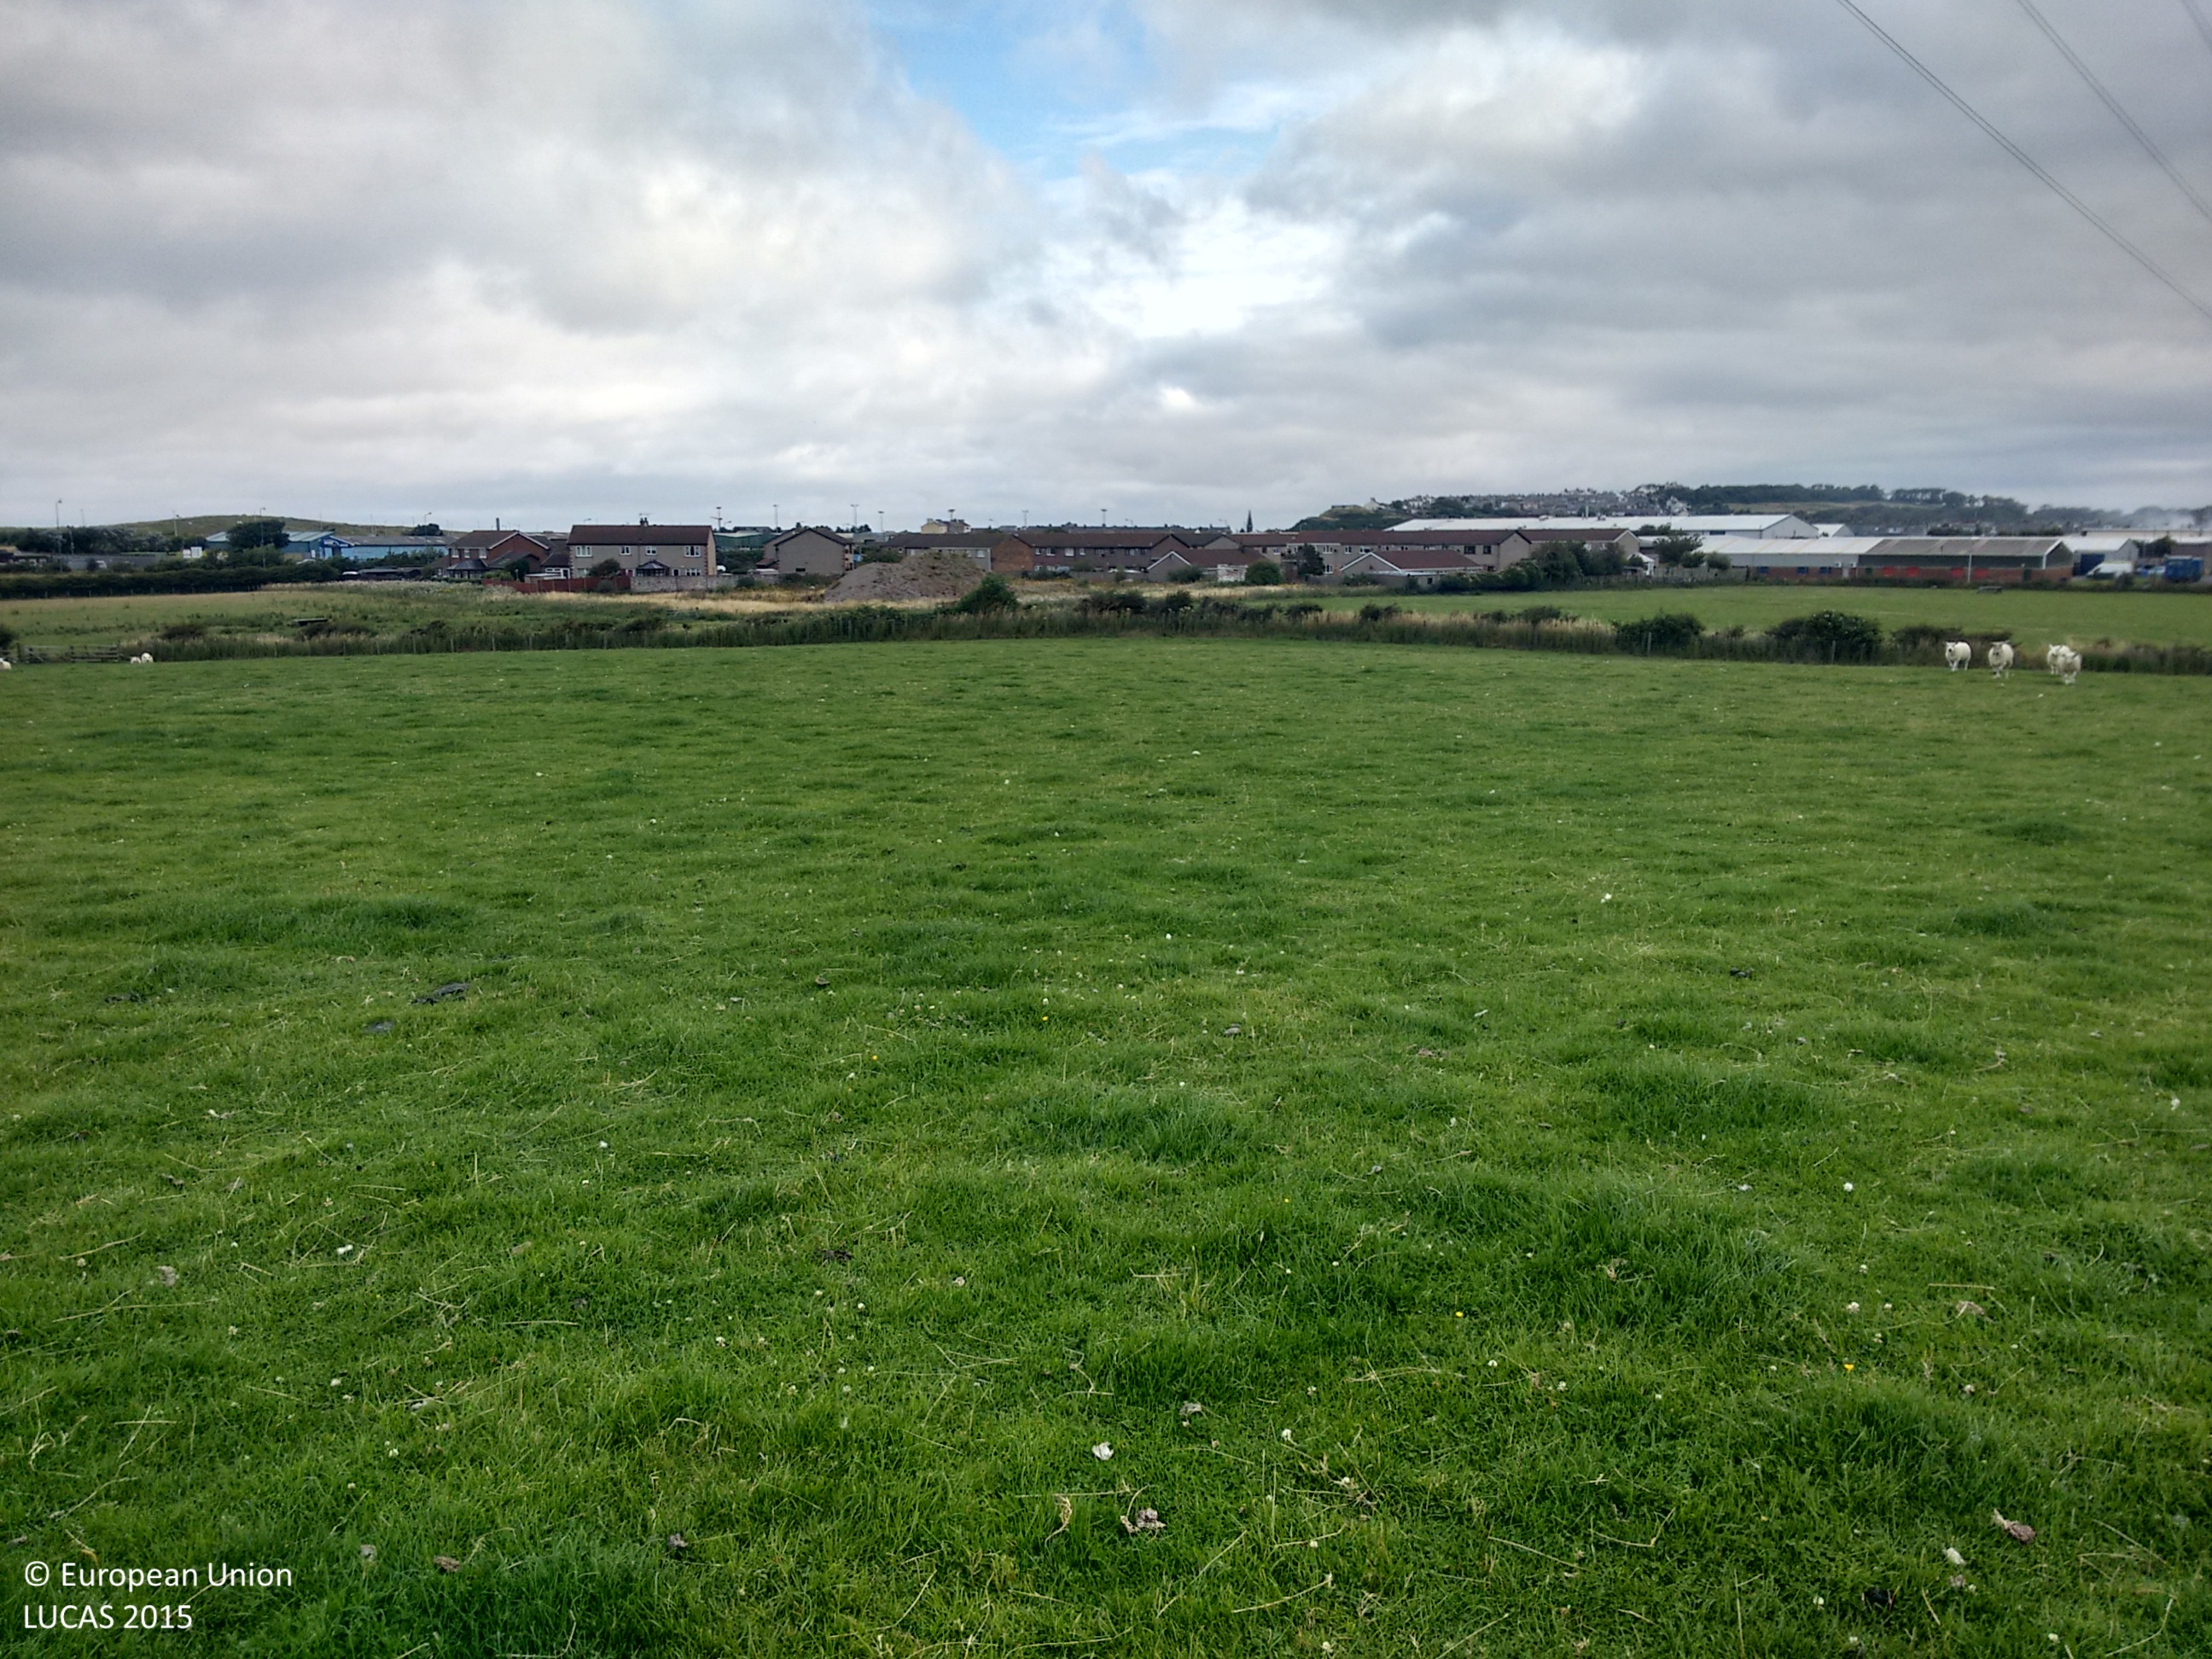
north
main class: Grassland
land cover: Grassland without tree/shrub cover
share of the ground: > 75 %
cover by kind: herbaceous plants 100 %
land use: Agriculture (excluding fallow land and kitchen gardens)
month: August
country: GB
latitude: 54.7027
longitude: -3.5049
